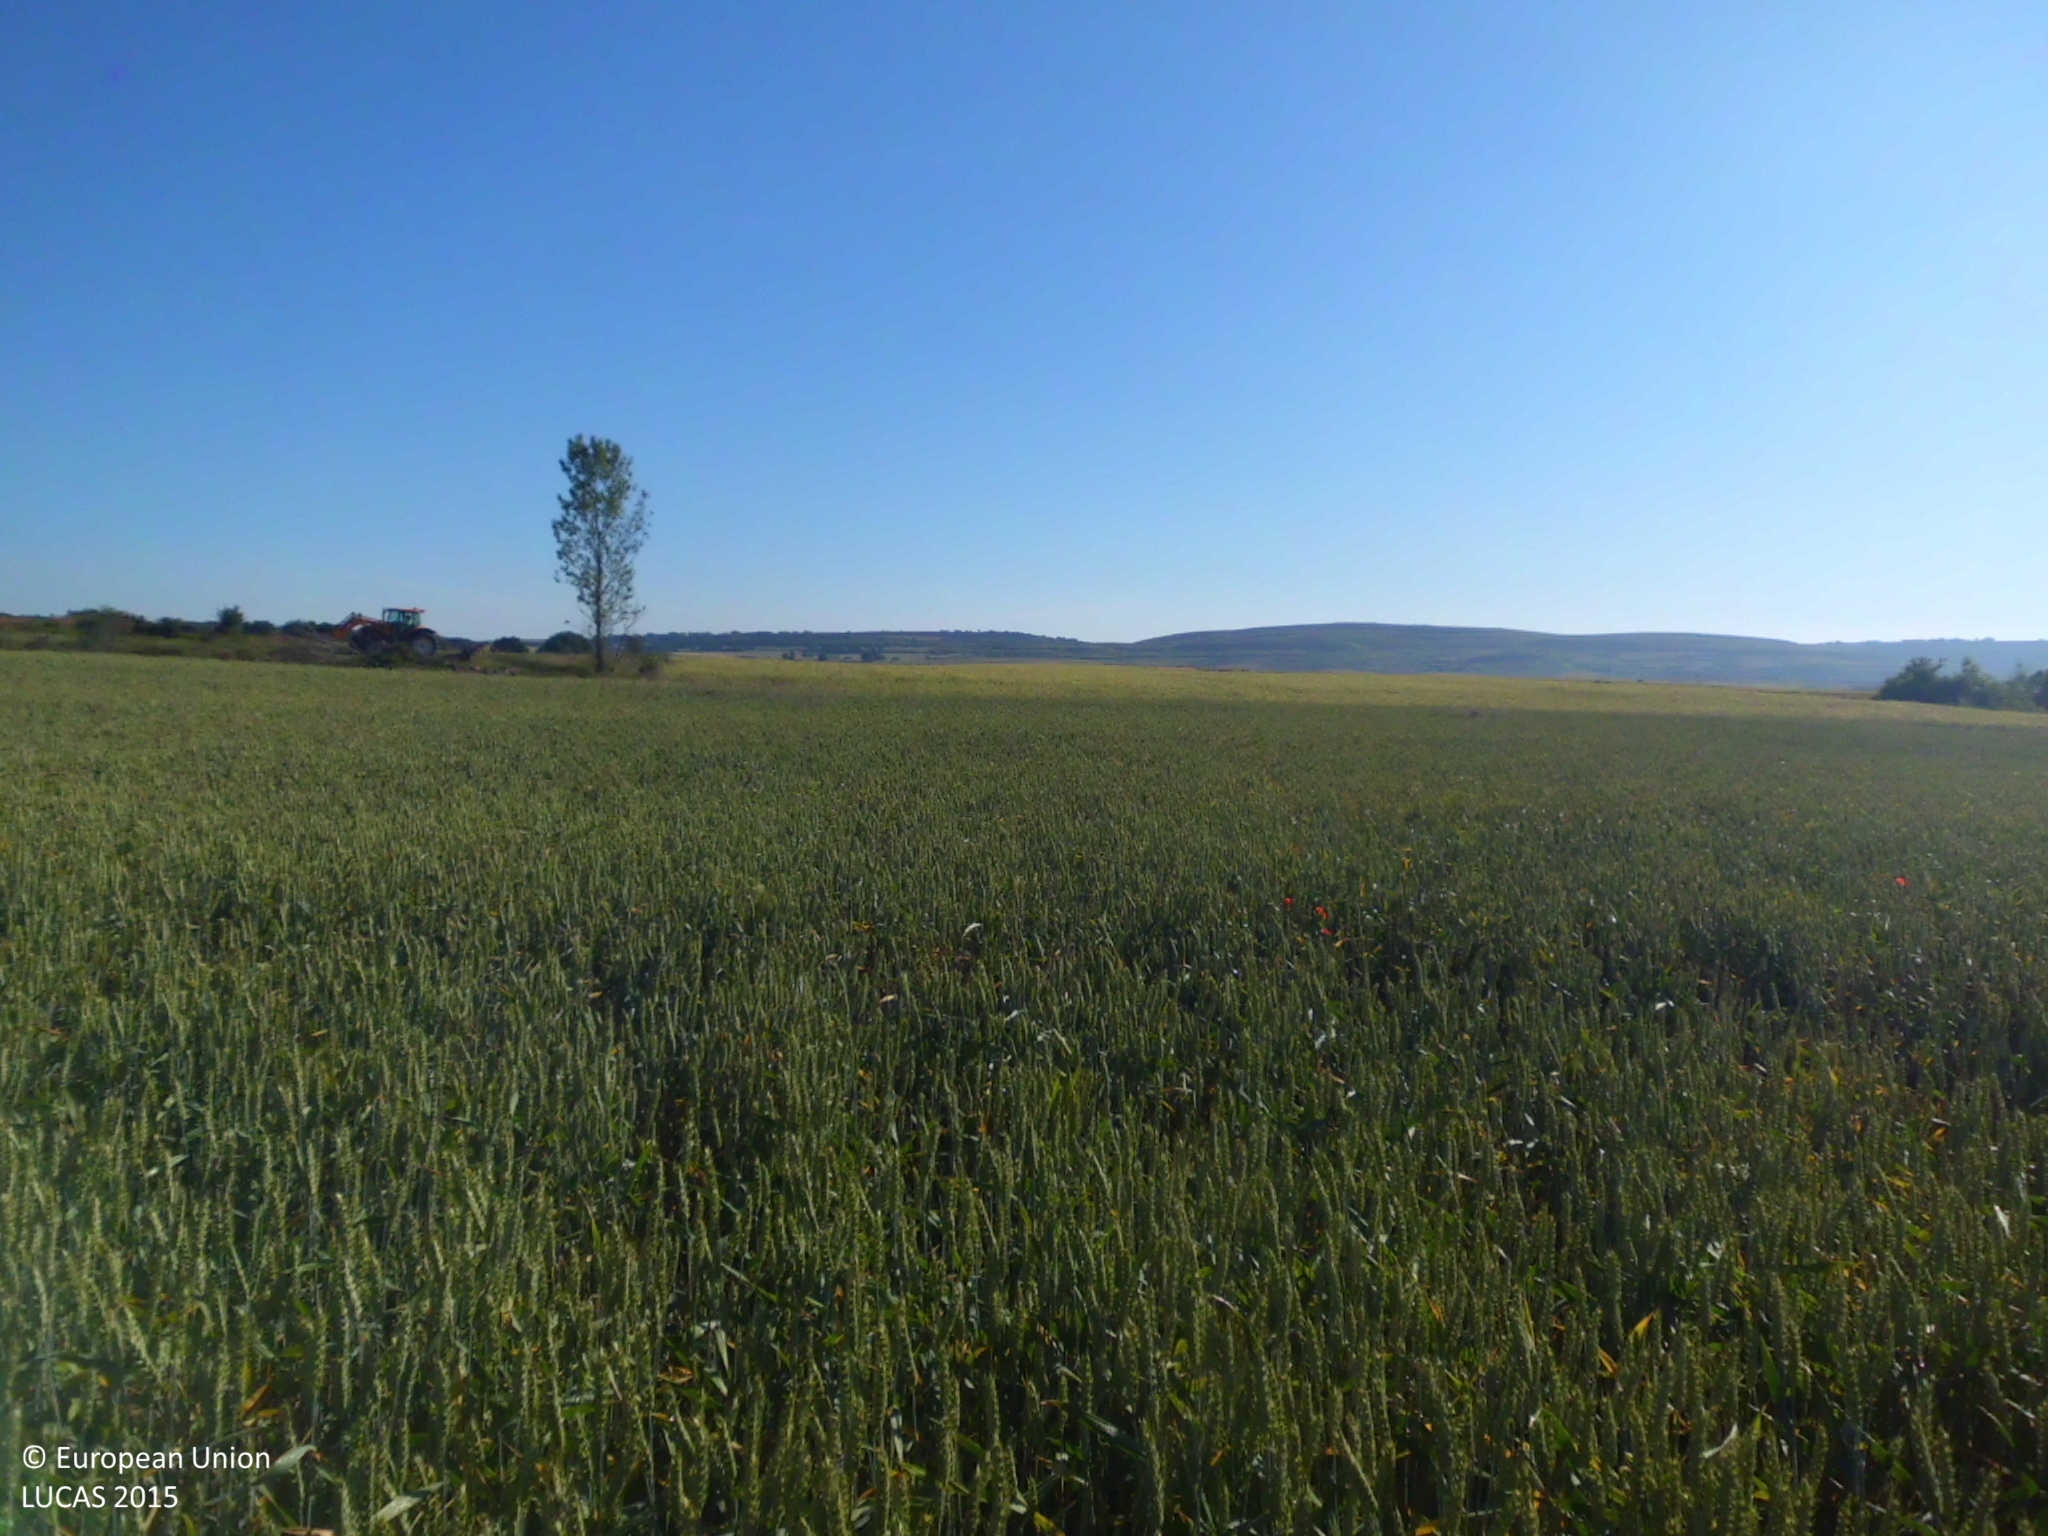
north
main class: Cropland
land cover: Common wheat
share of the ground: > 75 %
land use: Agriculture (excluding fallow land and kitchen gardens)
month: June
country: ES
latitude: 42.6548
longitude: -3.9375
